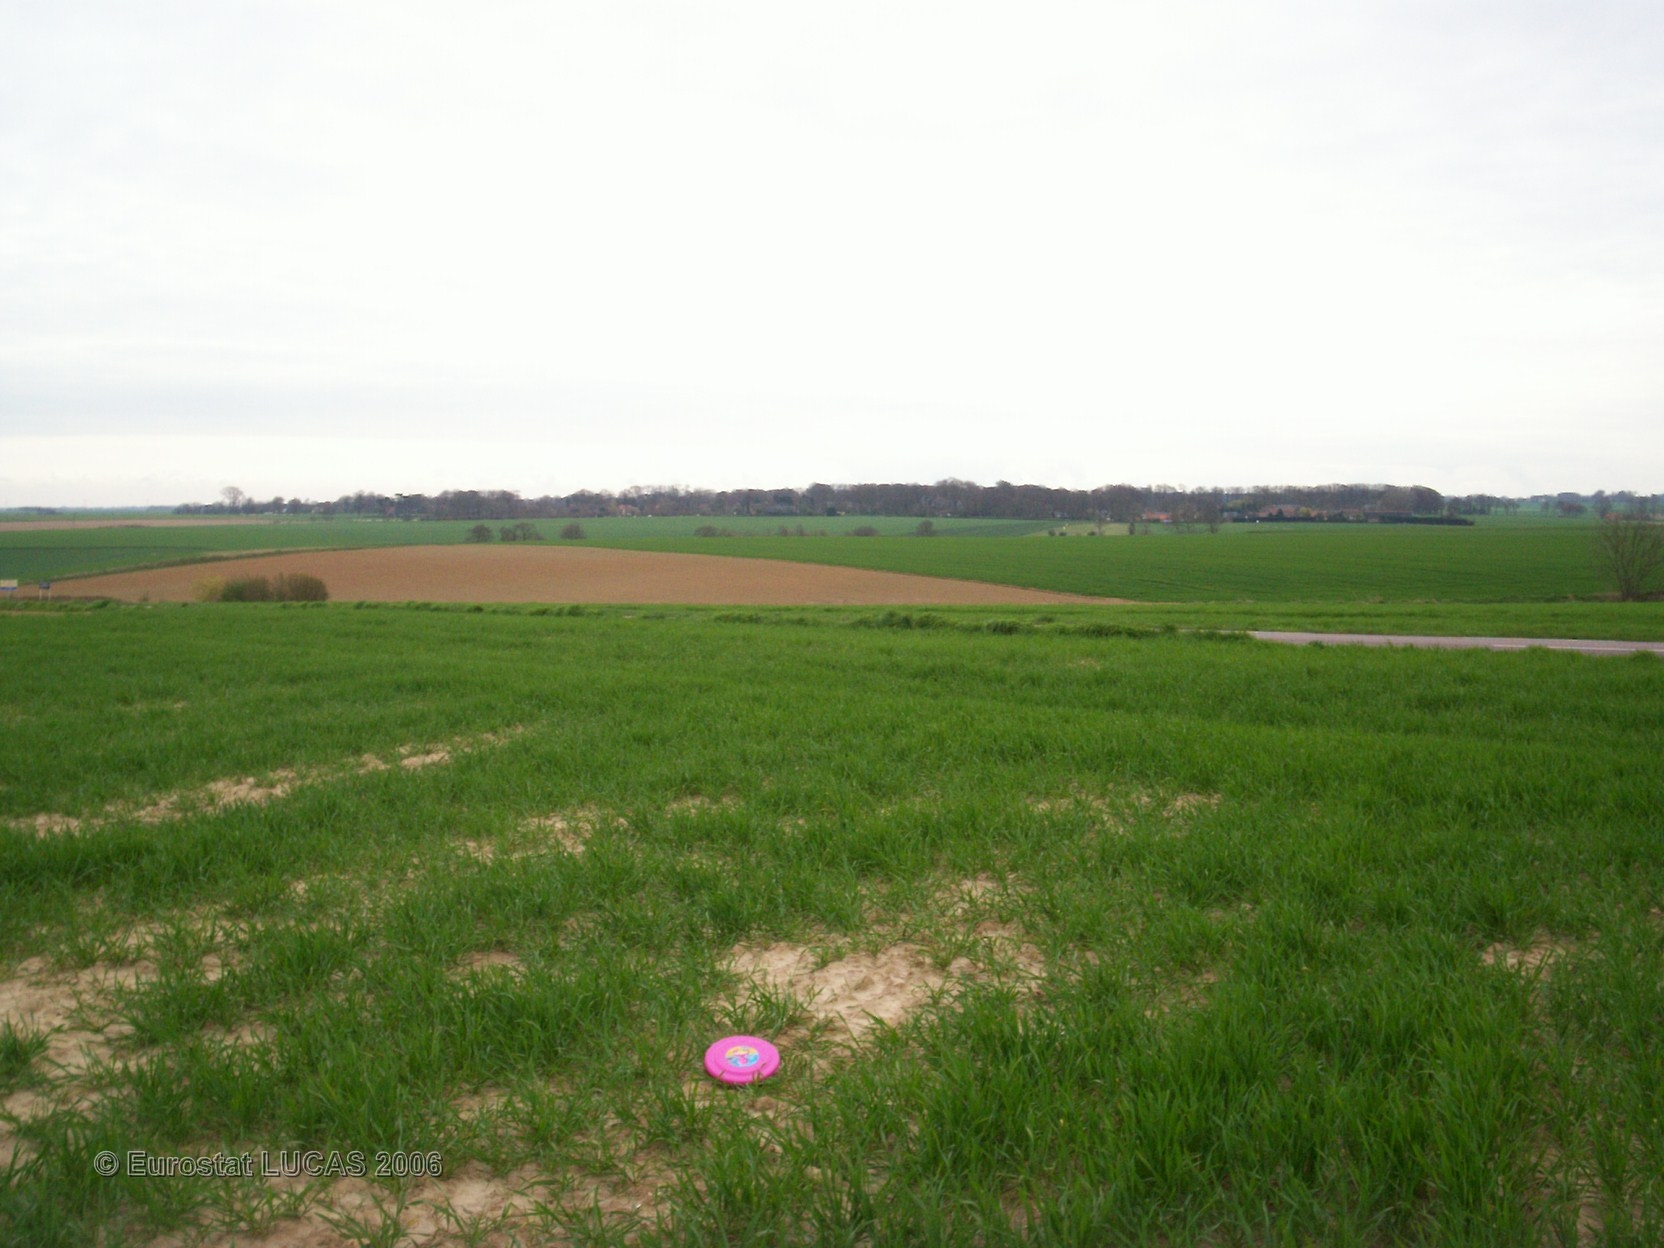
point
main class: Cropland
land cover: Common wheat
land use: Agriculture (excluding fallow land and kitchen gardens)
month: April
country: FR
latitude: 49.8642
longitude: 0.7797
